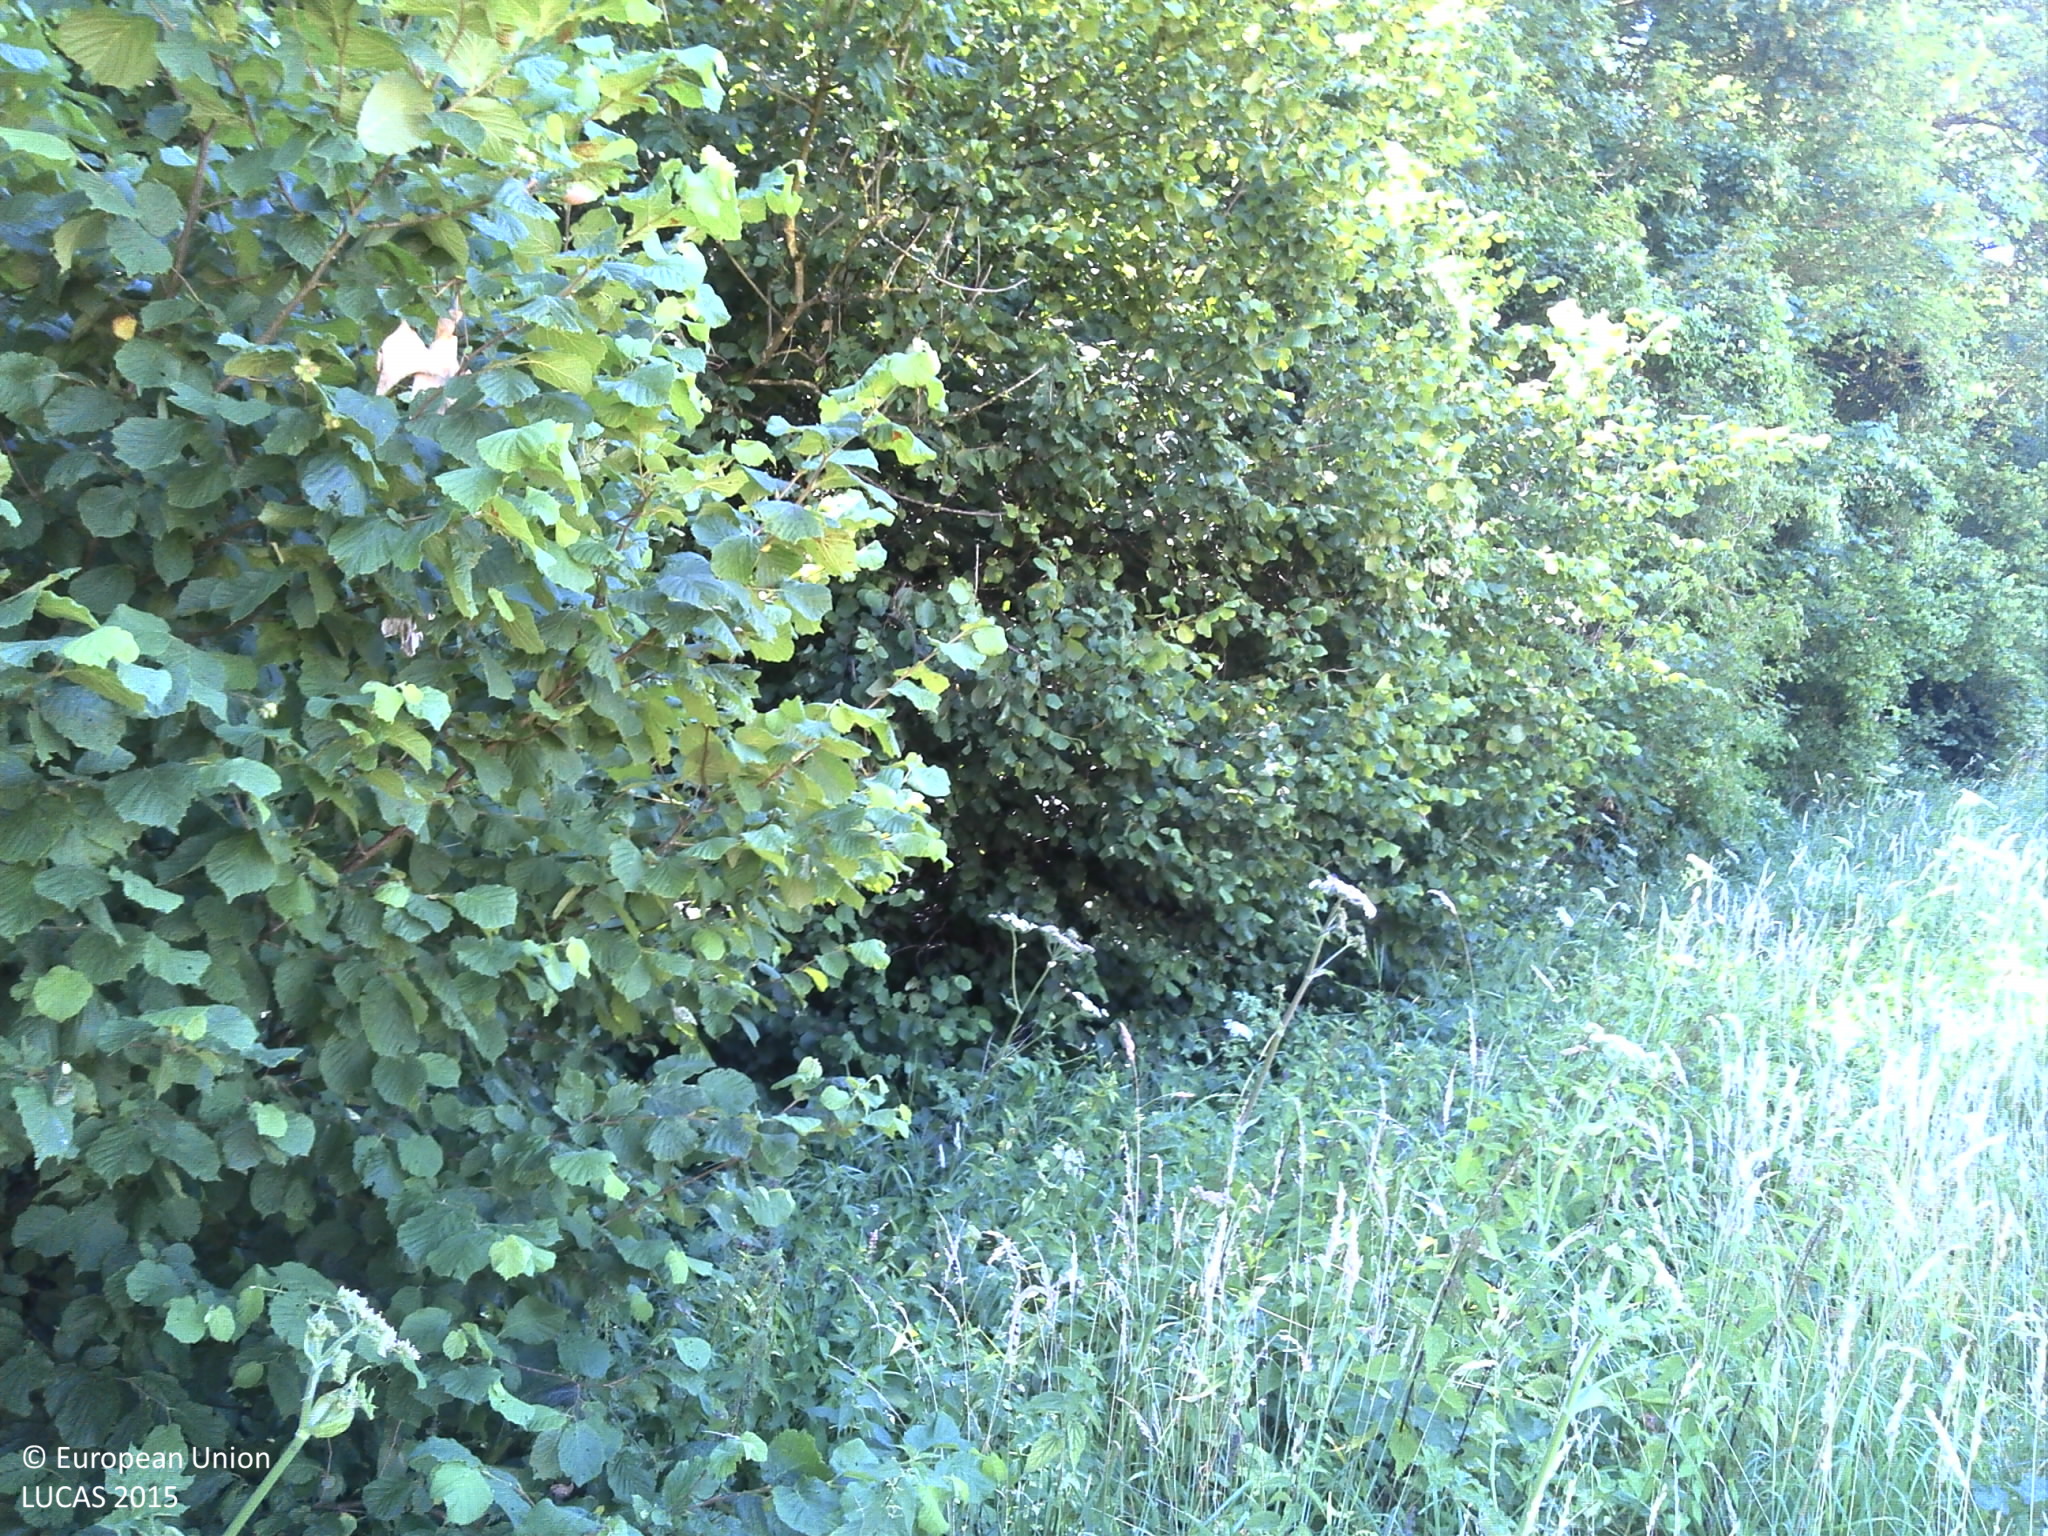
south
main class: Grassland
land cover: Grassland without tree/shrub cover
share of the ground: > 75 %
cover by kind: herbaceous plants 100 %
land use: Agriculture (excluding fallow land and kitchen gardens)
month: July
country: FR
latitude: 49.5718
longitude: 4.6451
